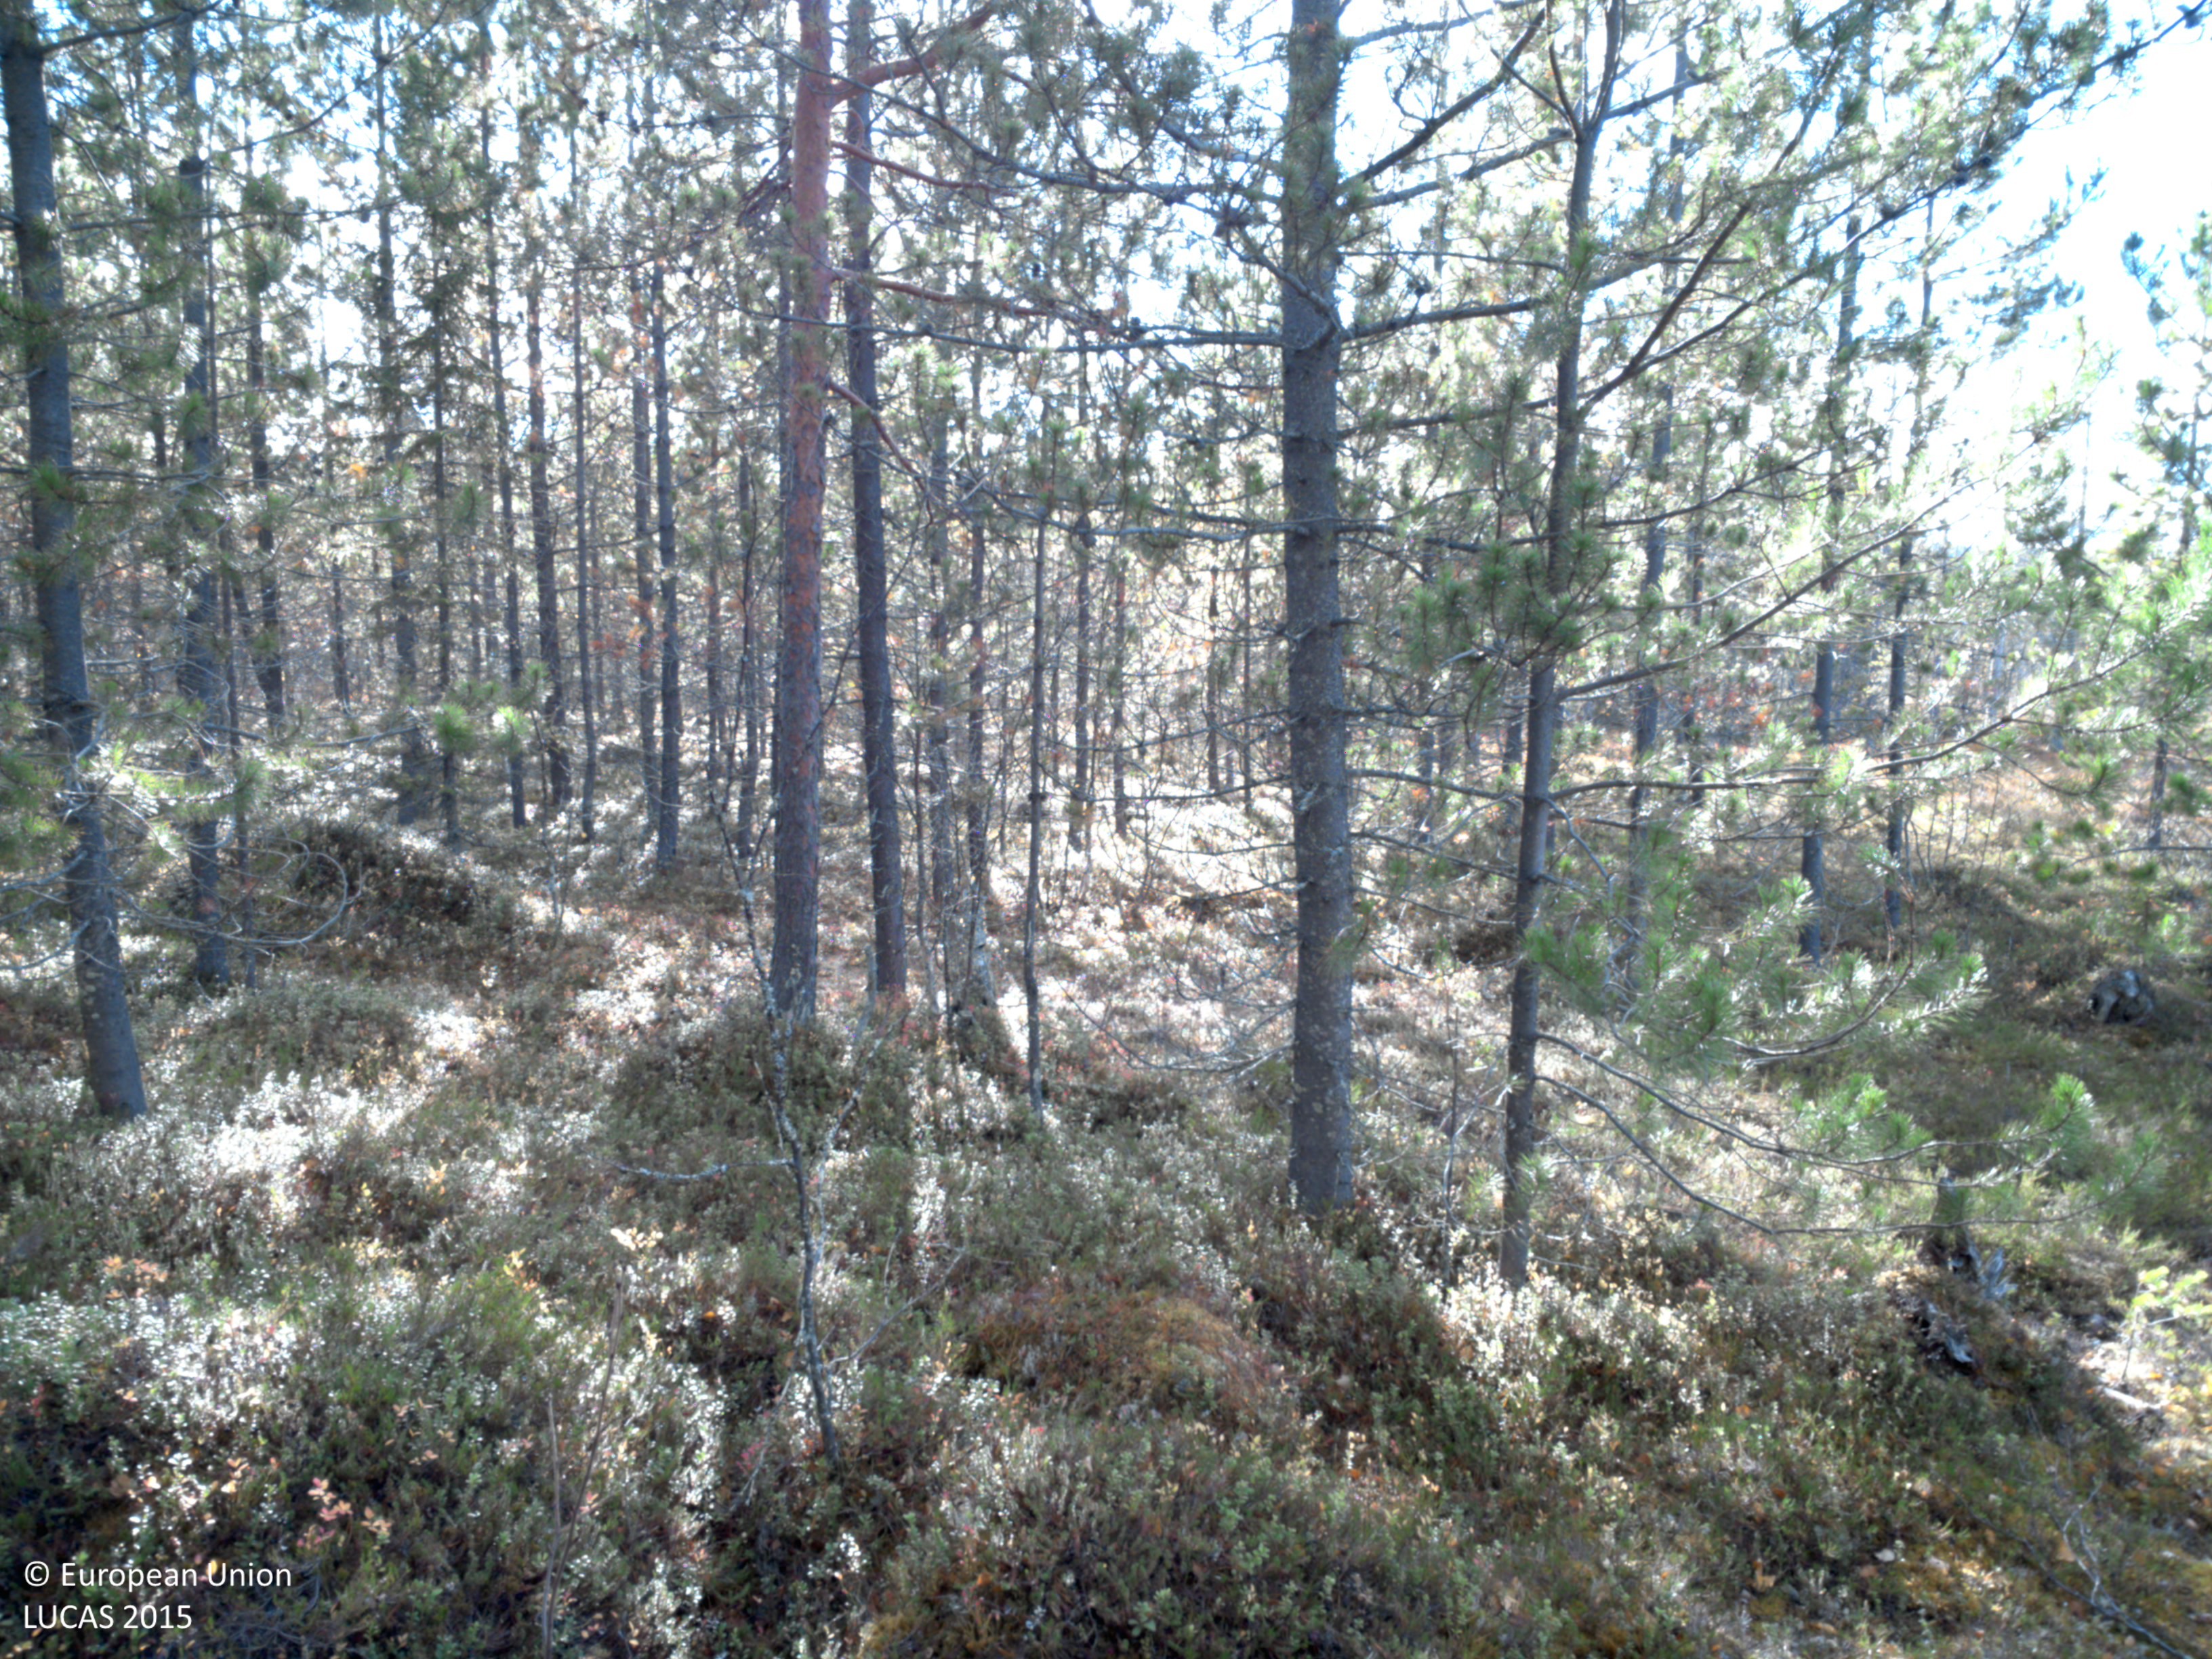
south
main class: Woodland
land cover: Pine dominated coniferous woodland
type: exotic forest
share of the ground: > 75 %
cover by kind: coniferous forest trees 75 %, shrubs 15 %, lichens and mosses 10 %
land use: Forestry
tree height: > 5 m
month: October
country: SE
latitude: 64.8067
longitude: 17.7763
